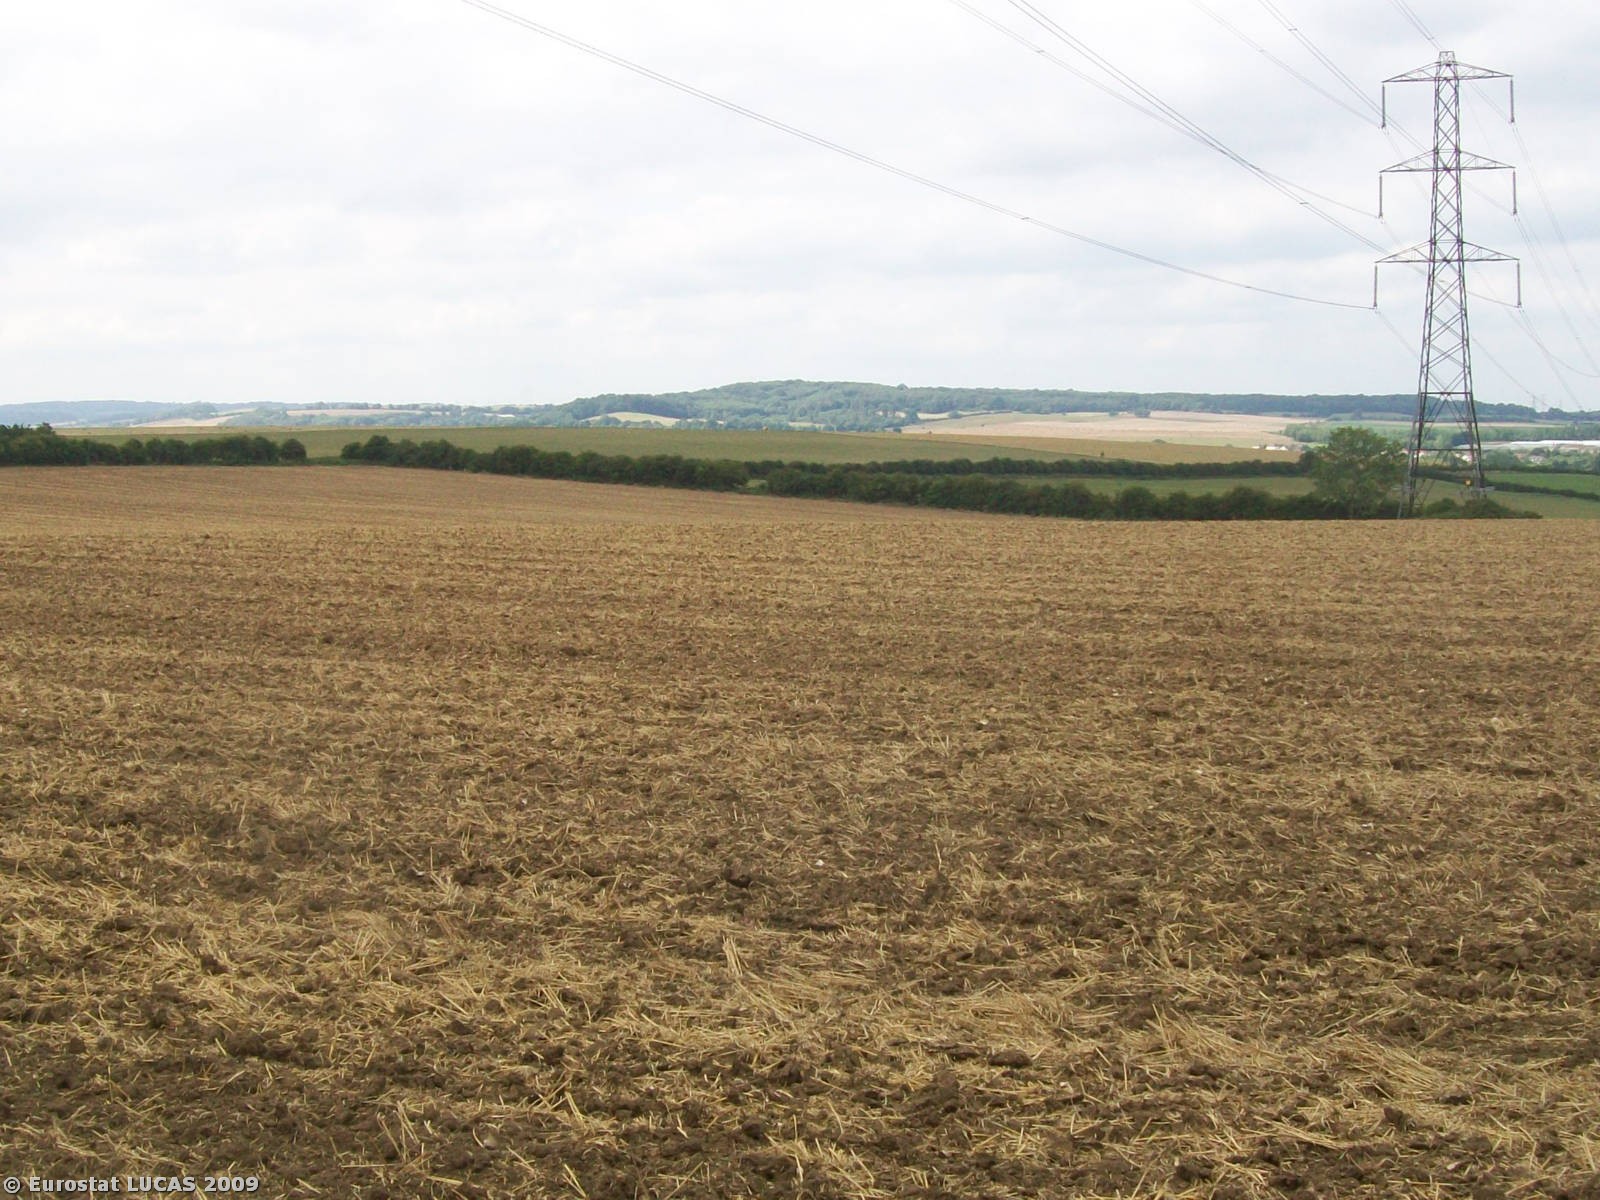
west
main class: Cropland
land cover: Common wheat
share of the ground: < 10 %
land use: Agriculture (excluding fallow land and kitchen gardens)
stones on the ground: 10 - 25 %
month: August
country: GB
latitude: 51.3972
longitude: 0.2680
